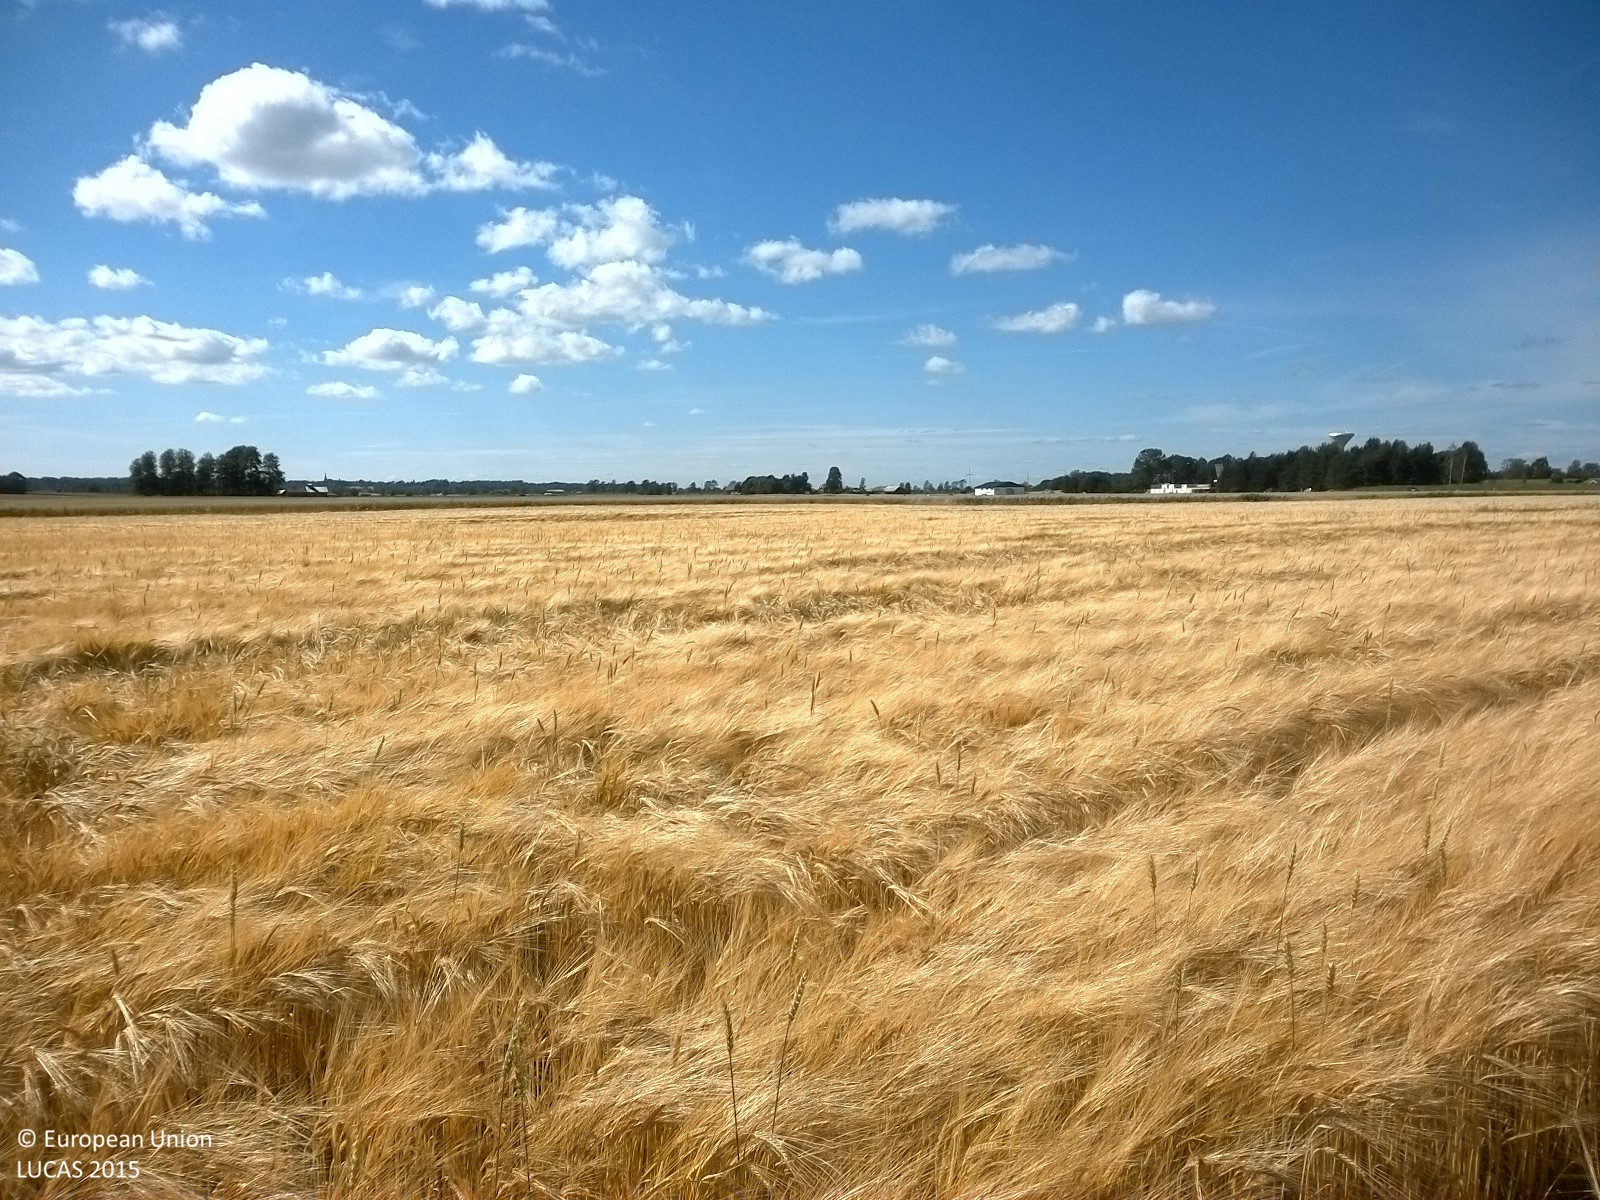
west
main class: Cropland
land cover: Barley
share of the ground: > 75 %
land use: Agriculture (excluding fallow land and kitchen gardens)
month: August
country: SE
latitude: 59.1518
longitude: 15.5348
